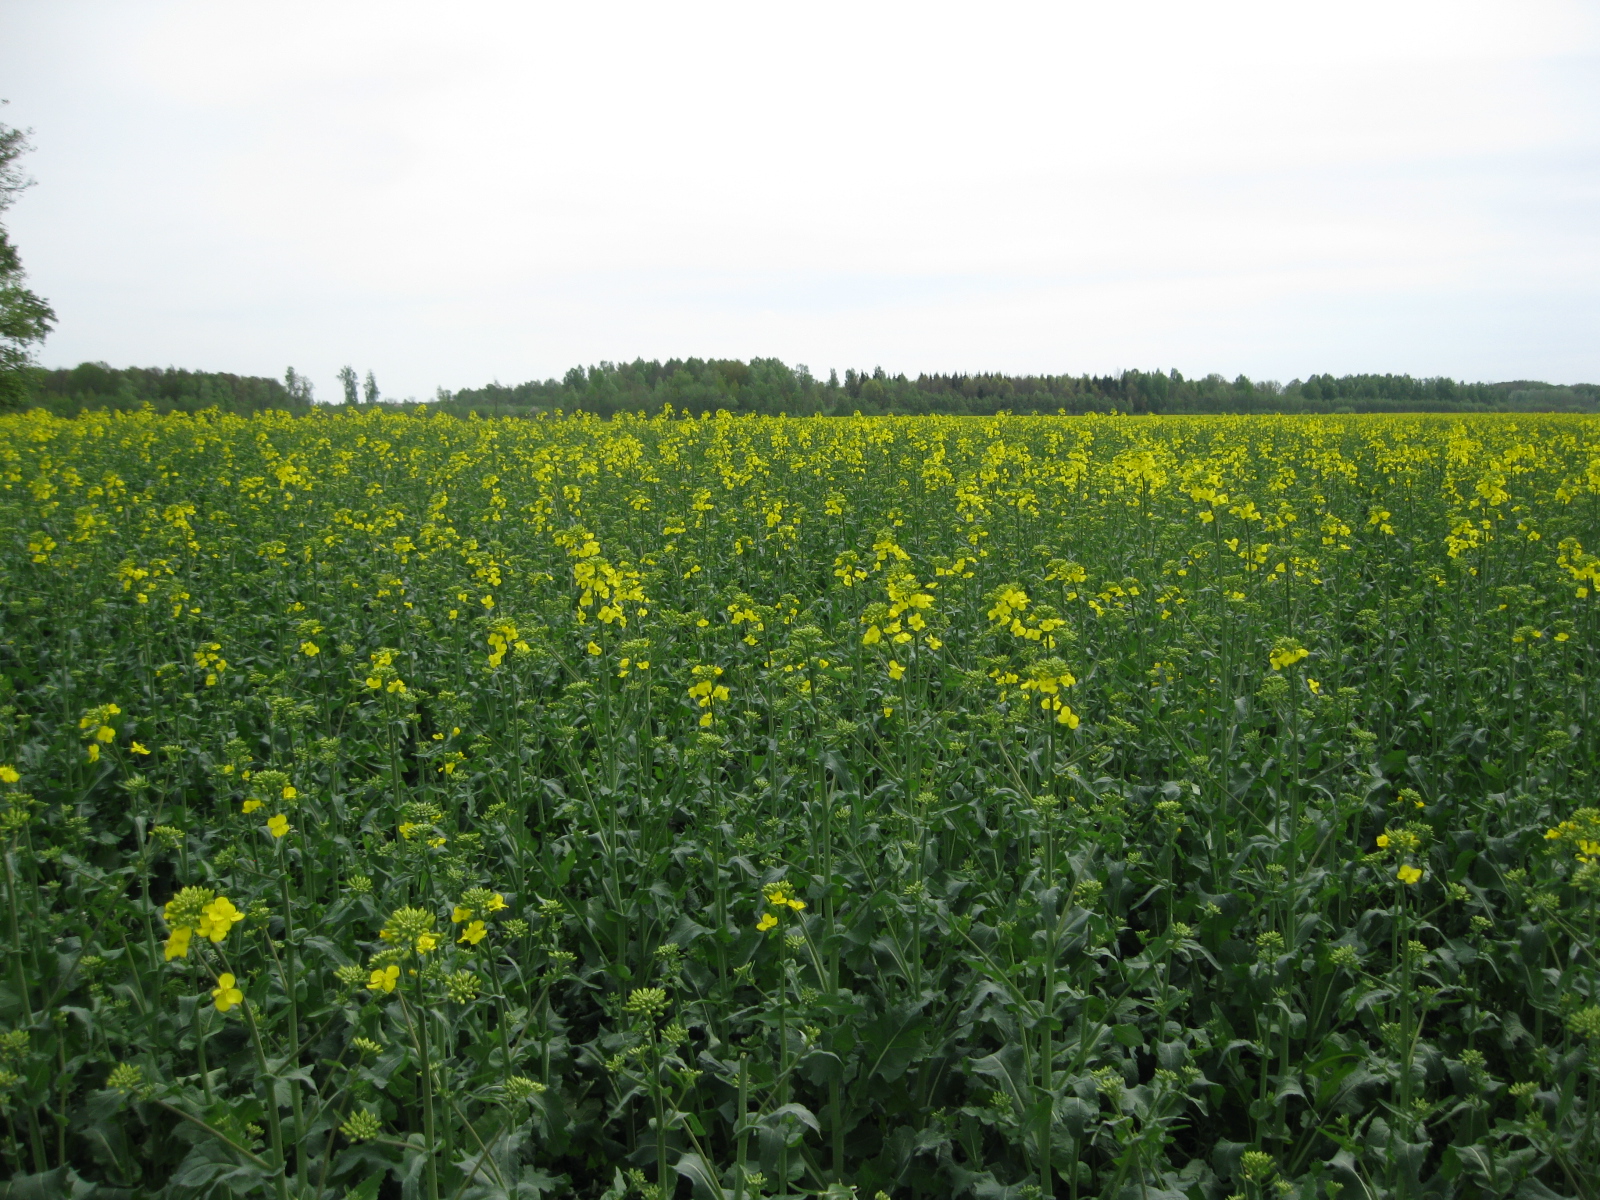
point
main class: Cropland
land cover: Rape and turnip rape
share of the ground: > 75 %
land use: Agriculture (excluding fallow land and kitchen gardens)
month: May
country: LT
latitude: 56.2647
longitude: 24.2510
